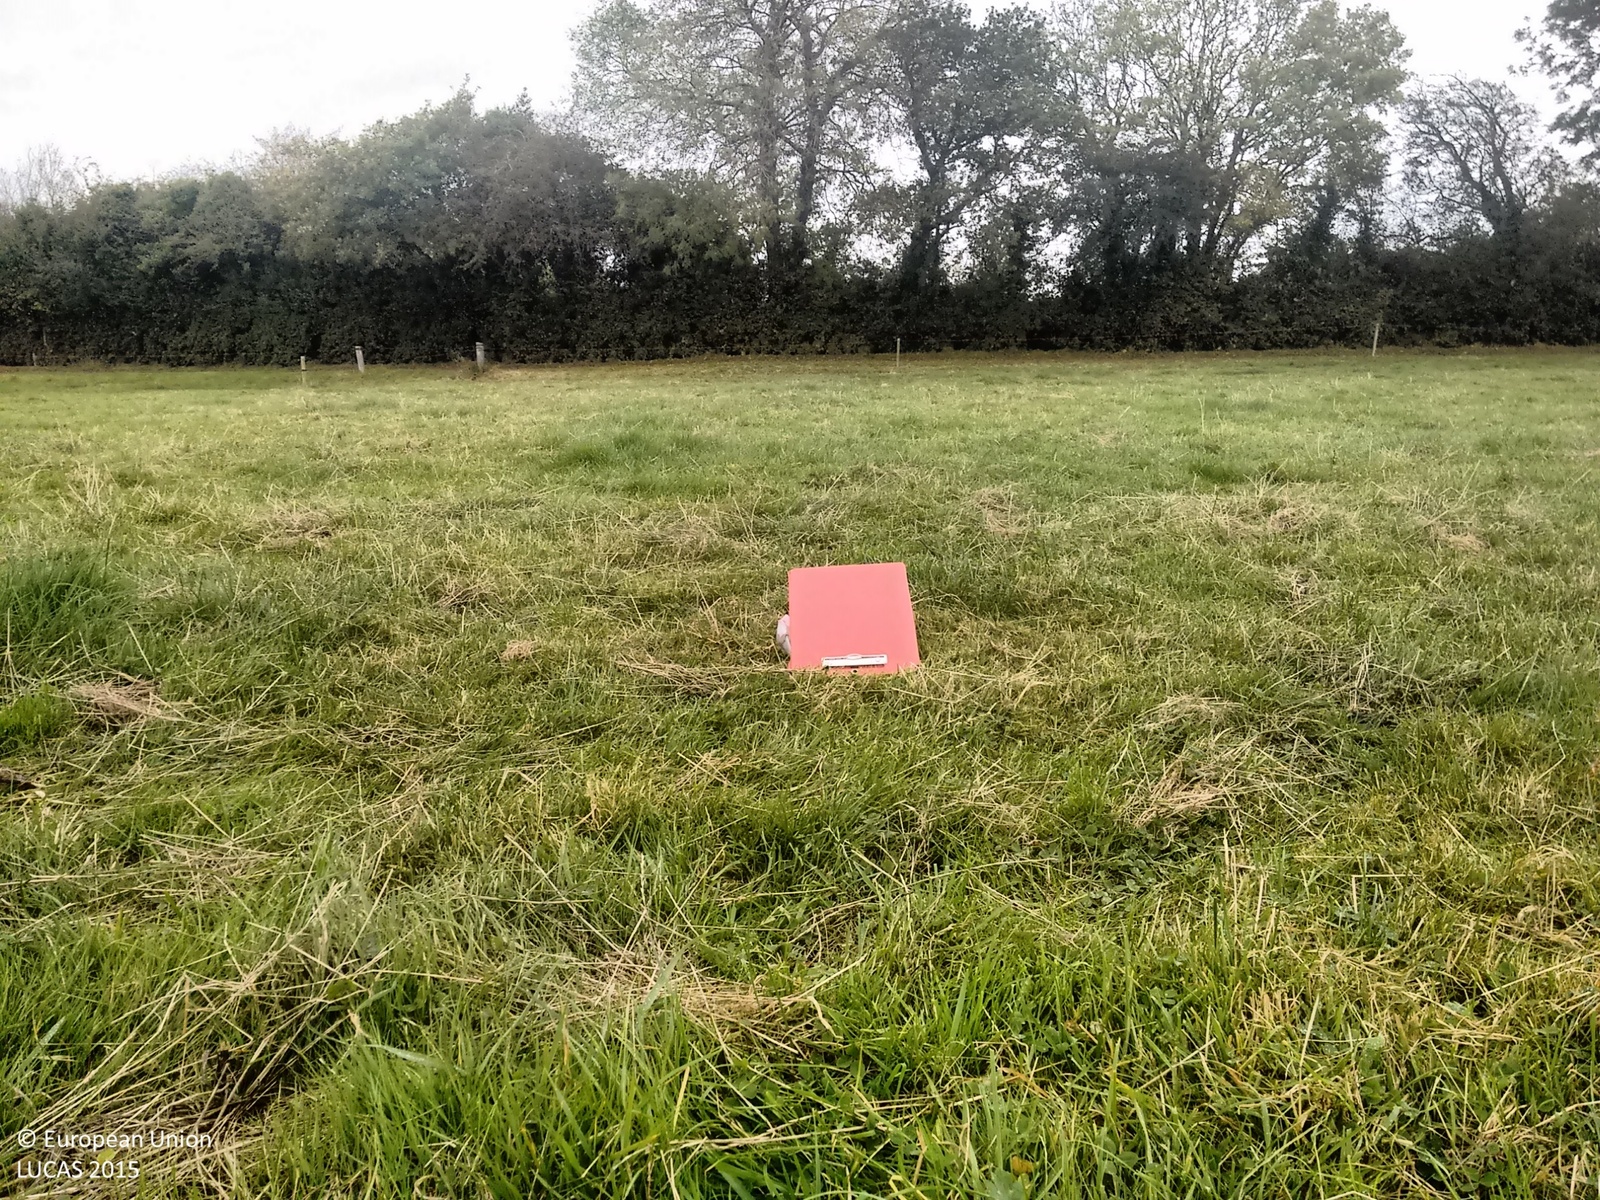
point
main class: Grassland
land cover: Grassland without tree/shrub cover
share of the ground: > 75 %
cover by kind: herbaceous plants 100 %
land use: Agriculture (excluding fallow land and kitchen gardens)
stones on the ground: < 10 %
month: October
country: IE
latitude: 53.1248
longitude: -7.8797
